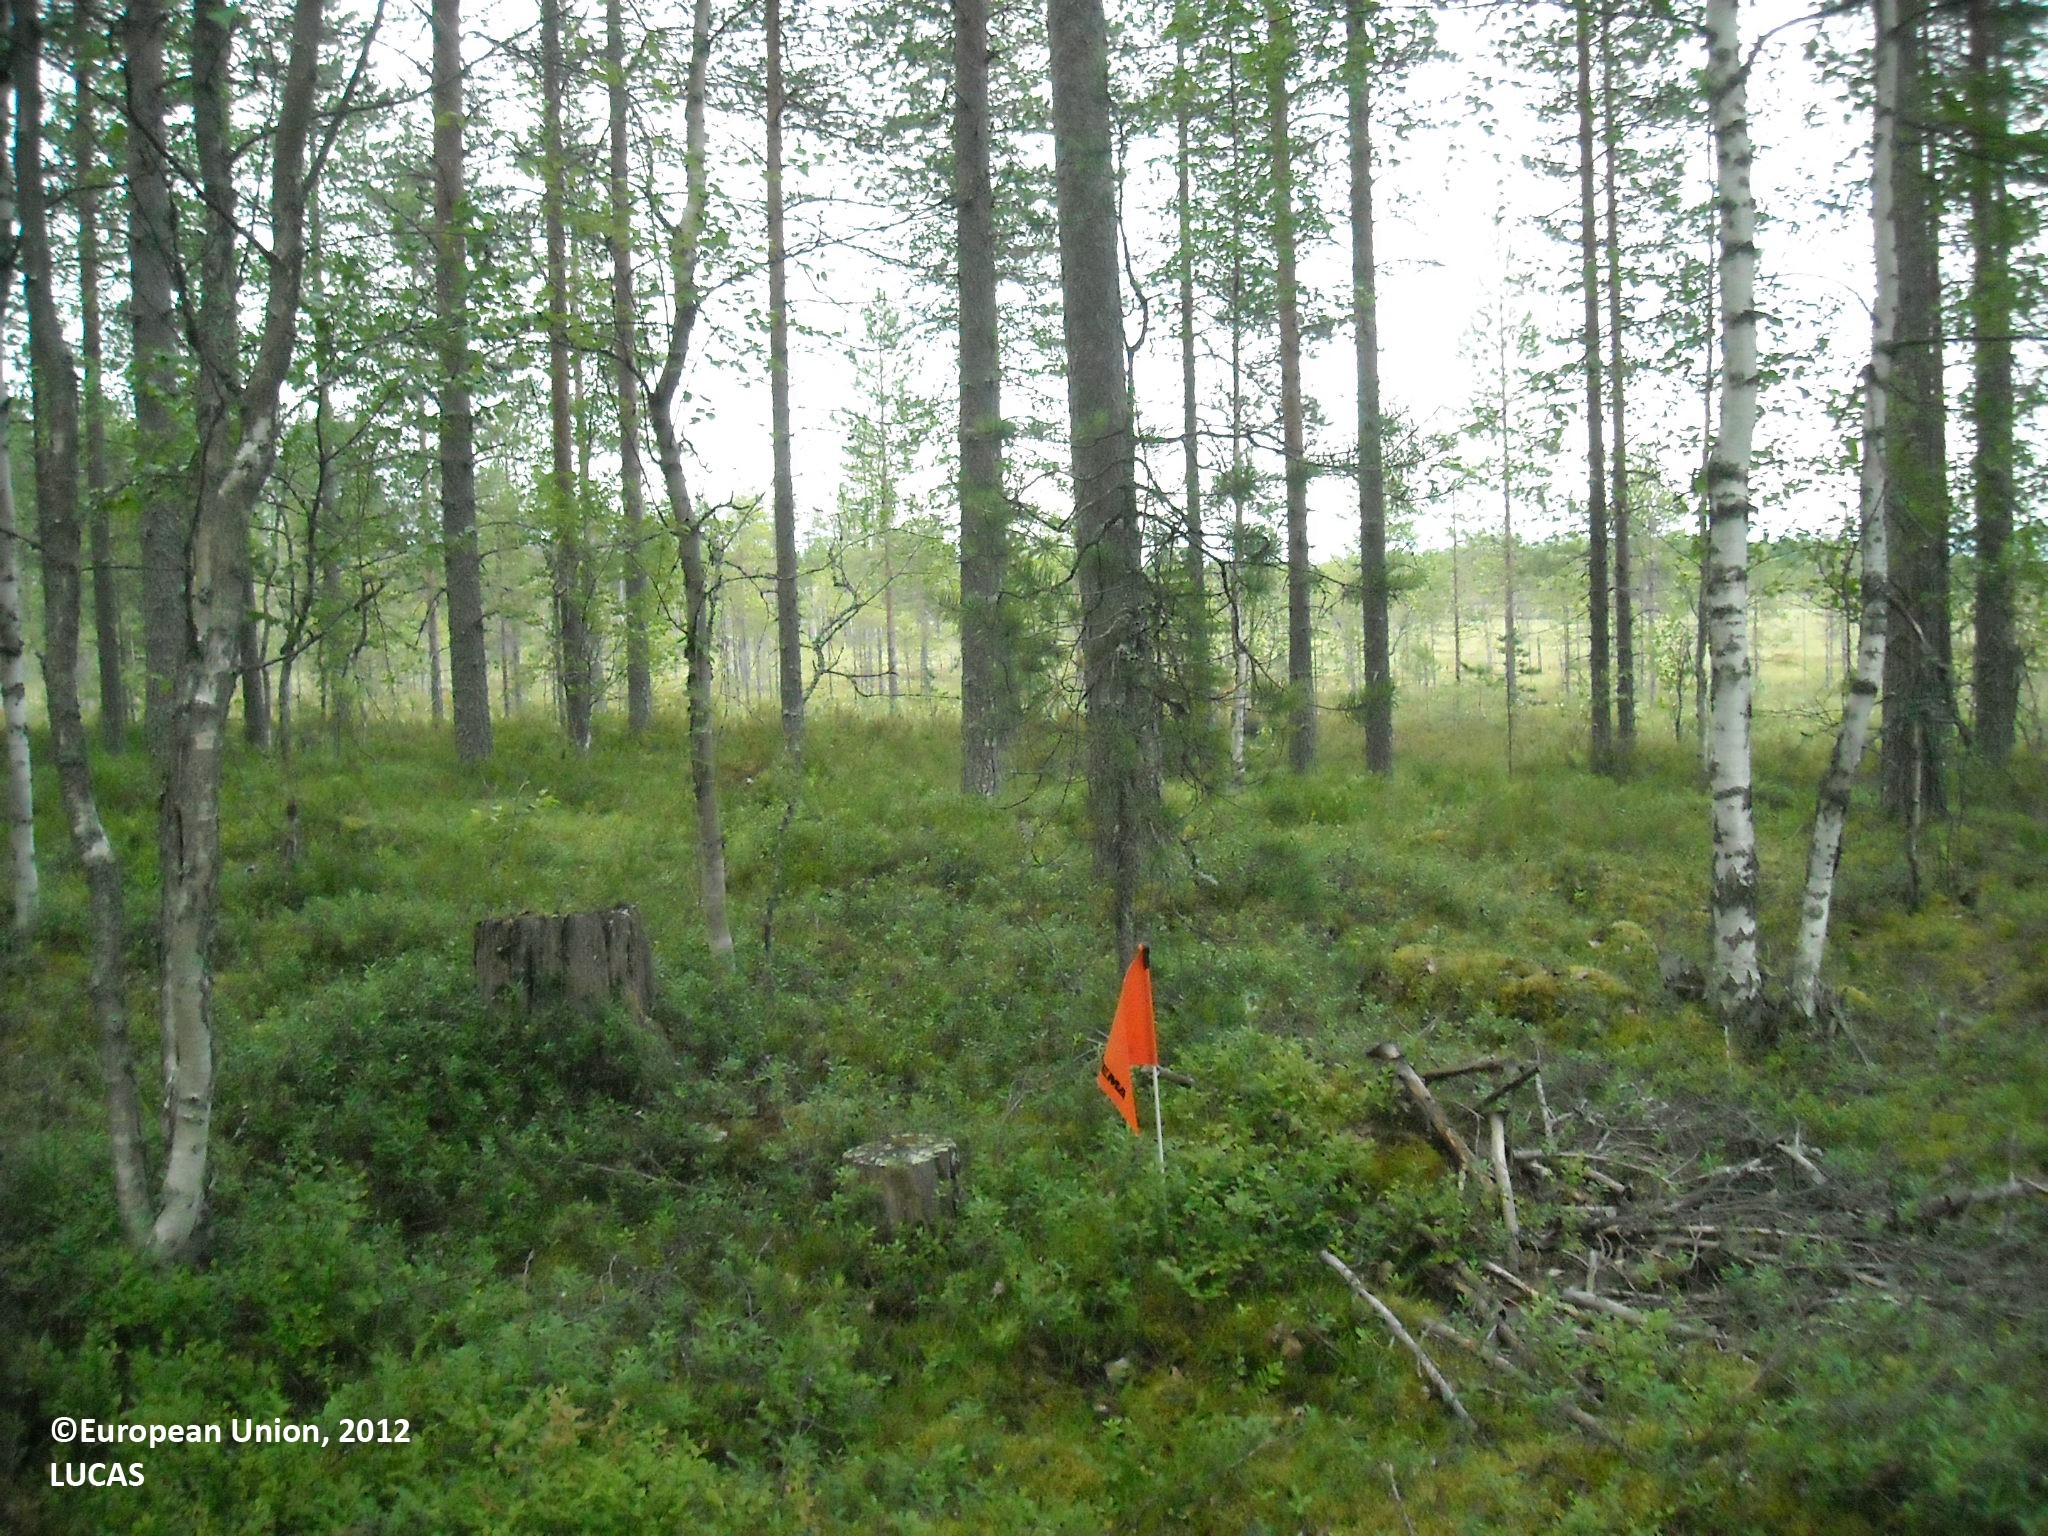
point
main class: Woodland
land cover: Pine dominated coniferous woodland
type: boreal forest
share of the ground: > 75 %
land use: Forestry
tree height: > 5 m
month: July
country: FI
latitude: 65.0440
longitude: 26.7026
